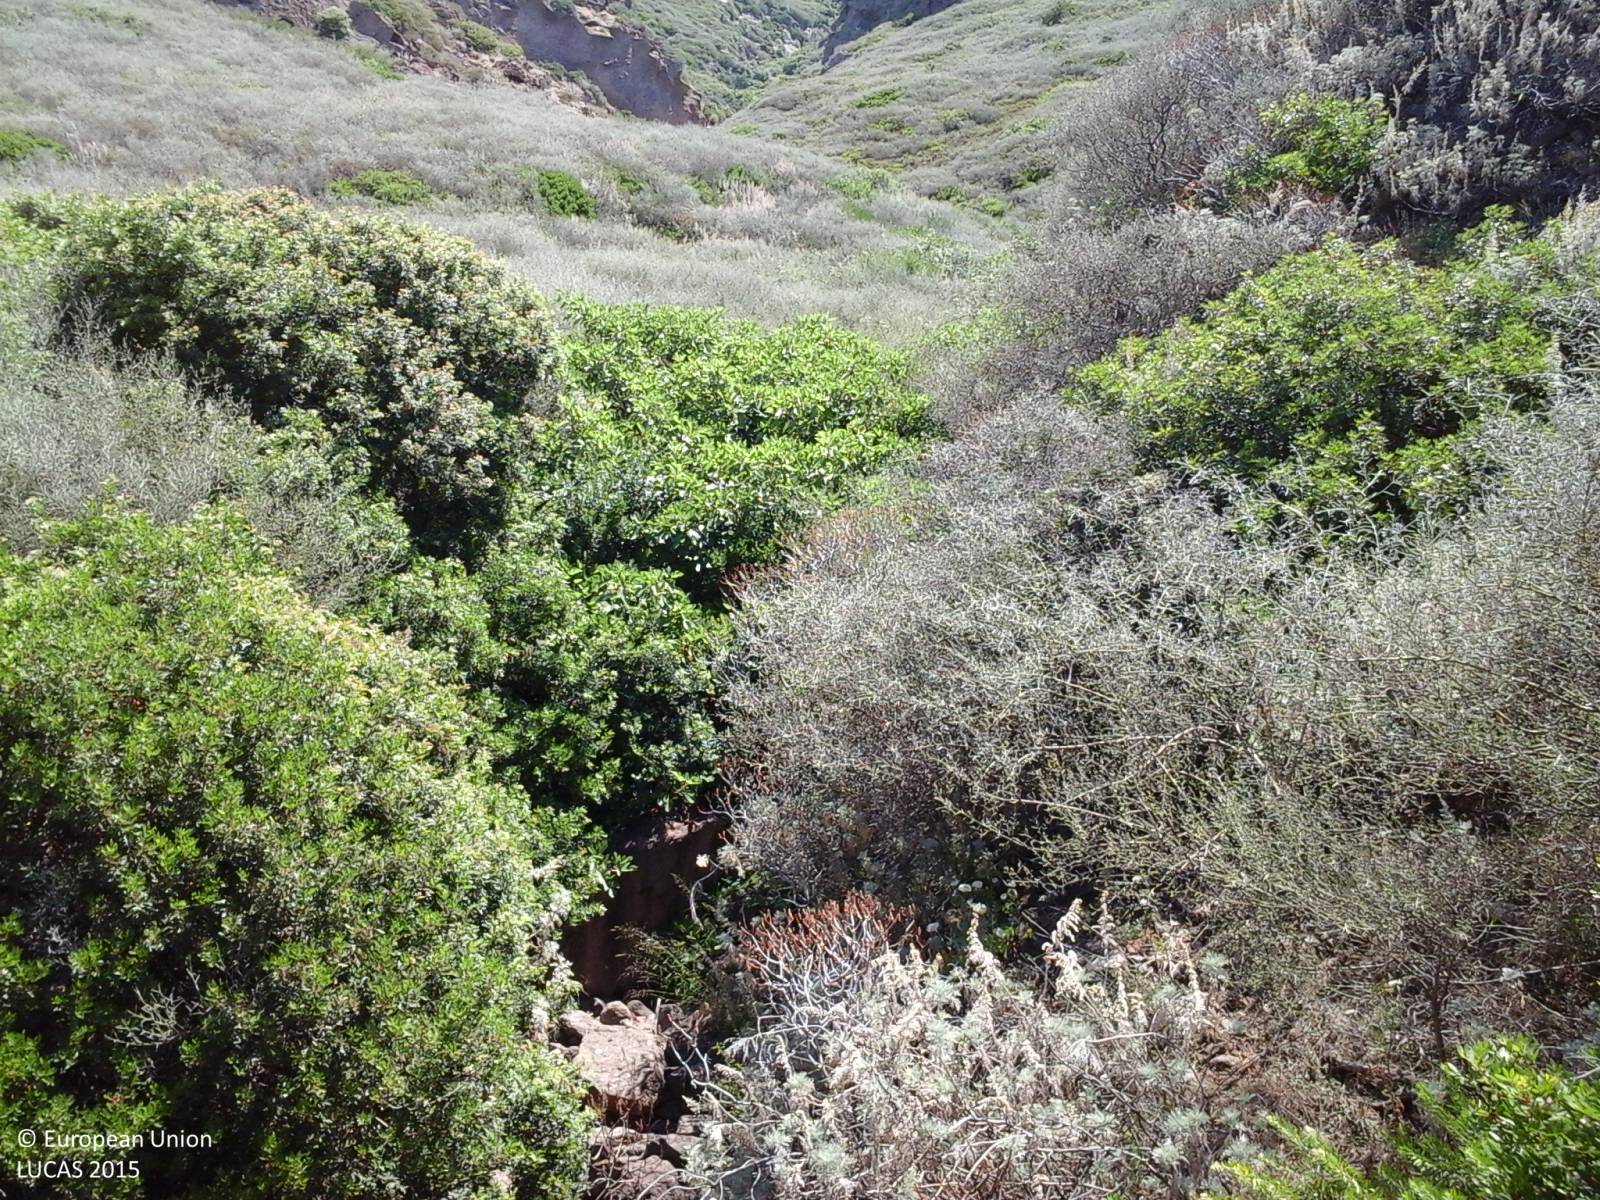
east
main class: Shrubland
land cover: Shrubland without tree cover
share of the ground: > 75 %
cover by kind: shrubs 90 %, consolidated bare surface 10 %
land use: Semi-natural and natural areas not in use
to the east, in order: Shrubland without tree cover; Rock outcrops; Shrubland without tree cover
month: June
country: IT
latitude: 40.4533
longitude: 8.3926
